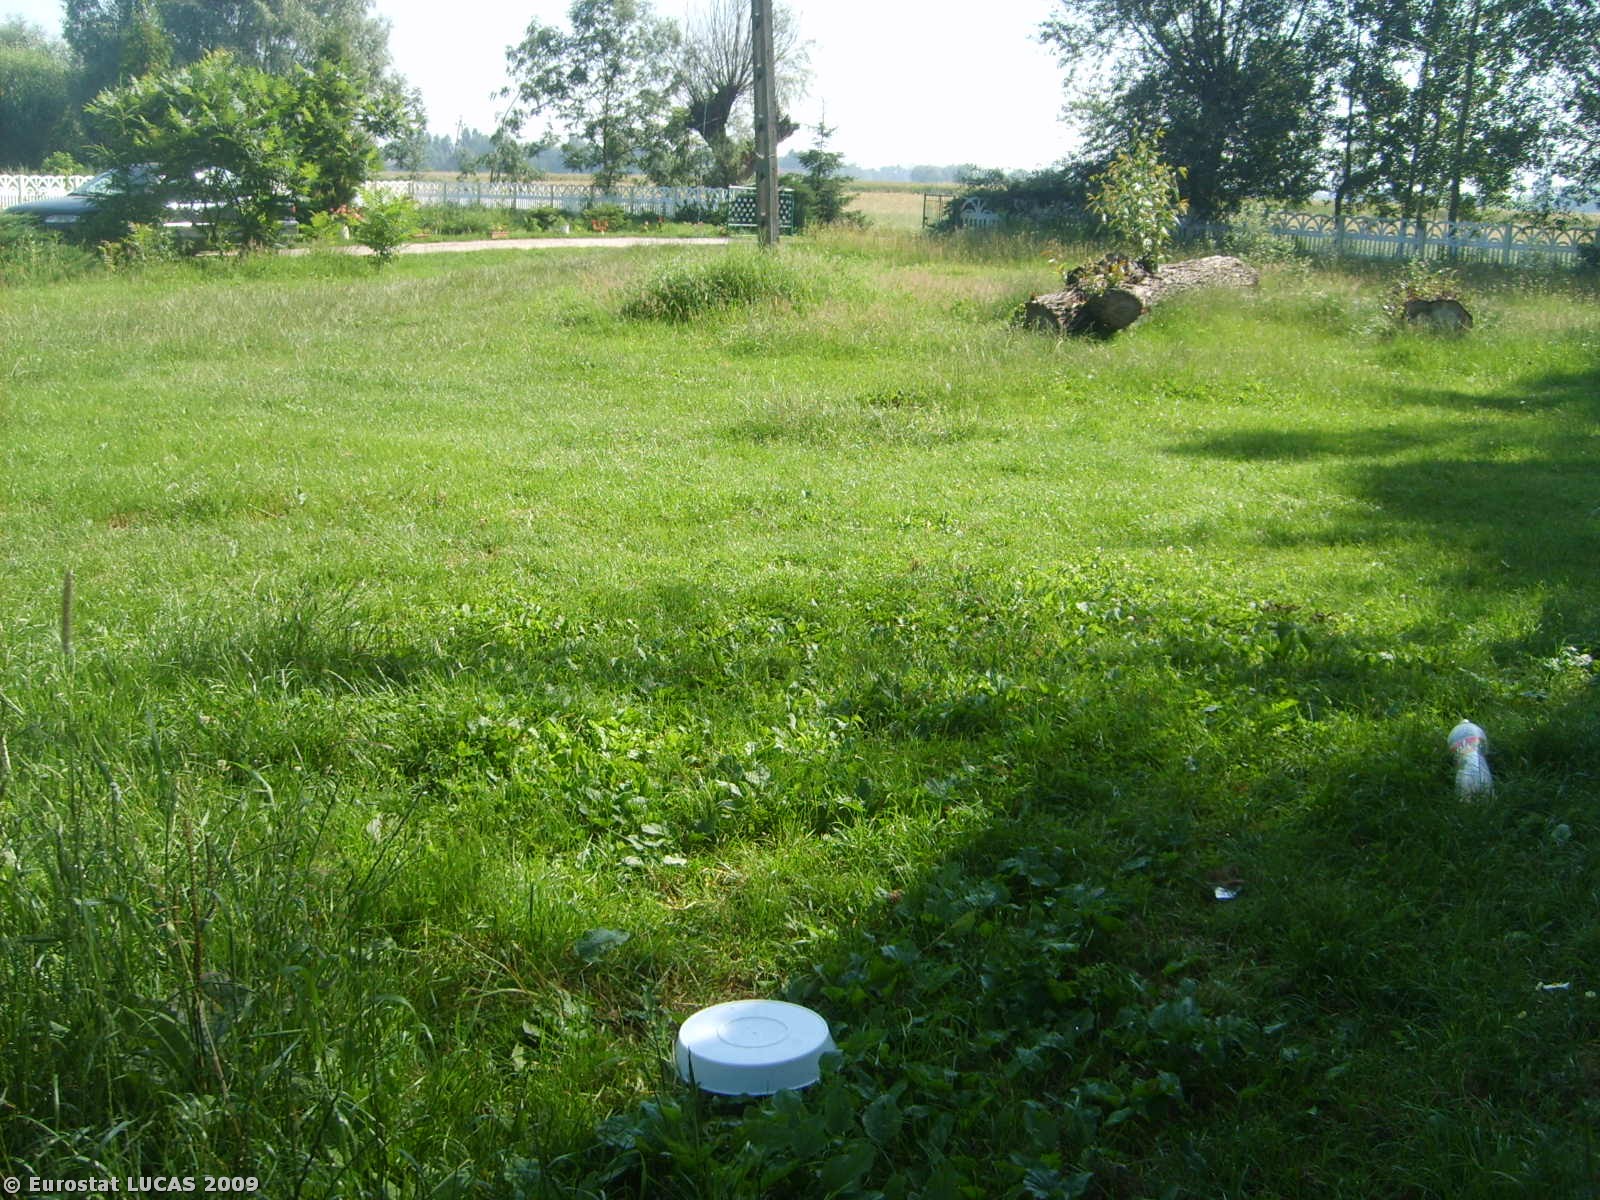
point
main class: Grassland
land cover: Grassland without tree/shrub cover
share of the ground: > 75 %
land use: Agriculture (excluding fallow land and kitchen gardens)
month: July
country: PL
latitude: 50.3602
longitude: 21.1650
